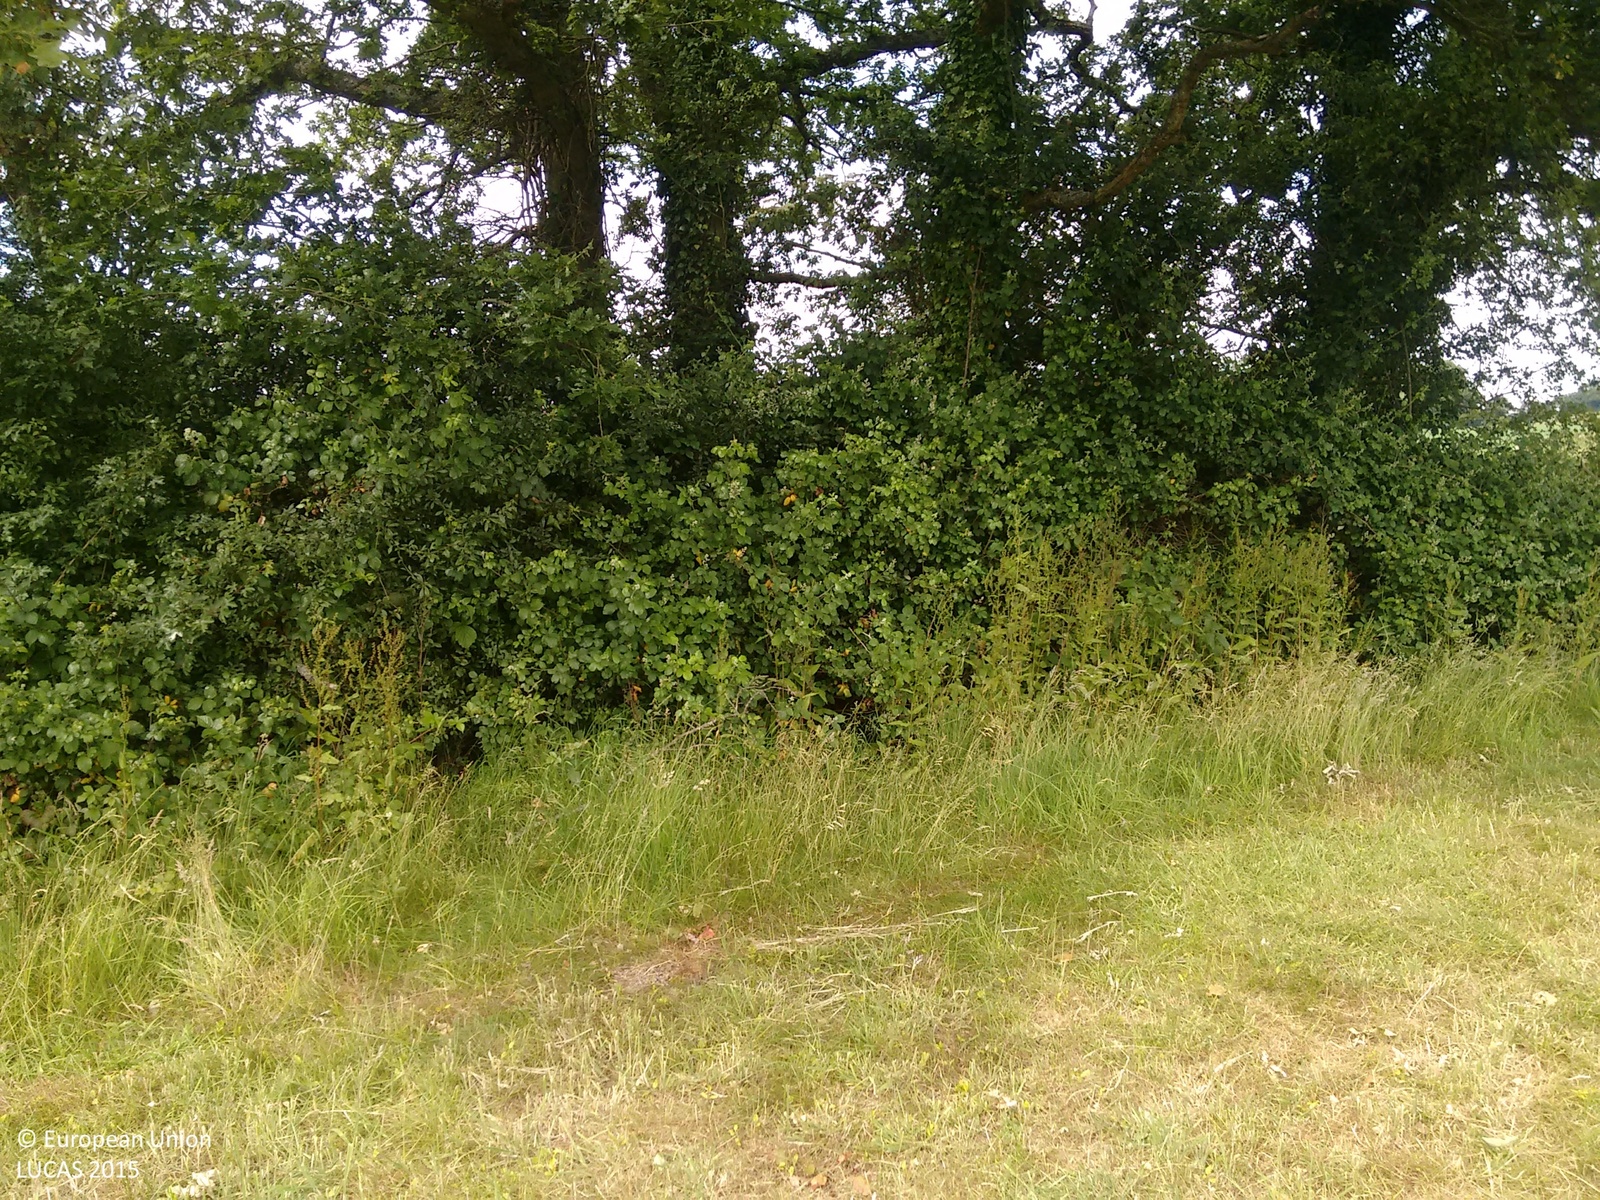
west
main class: Grassland
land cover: Grassland without tree/shrub cover
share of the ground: > 75 %
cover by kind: herbaceous plants 100 %
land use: Agriculture (excluding fallow land and kitchen gardens)
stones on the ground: < 10 %
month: June
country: GB
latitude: 51.2208
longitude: -0.0994
